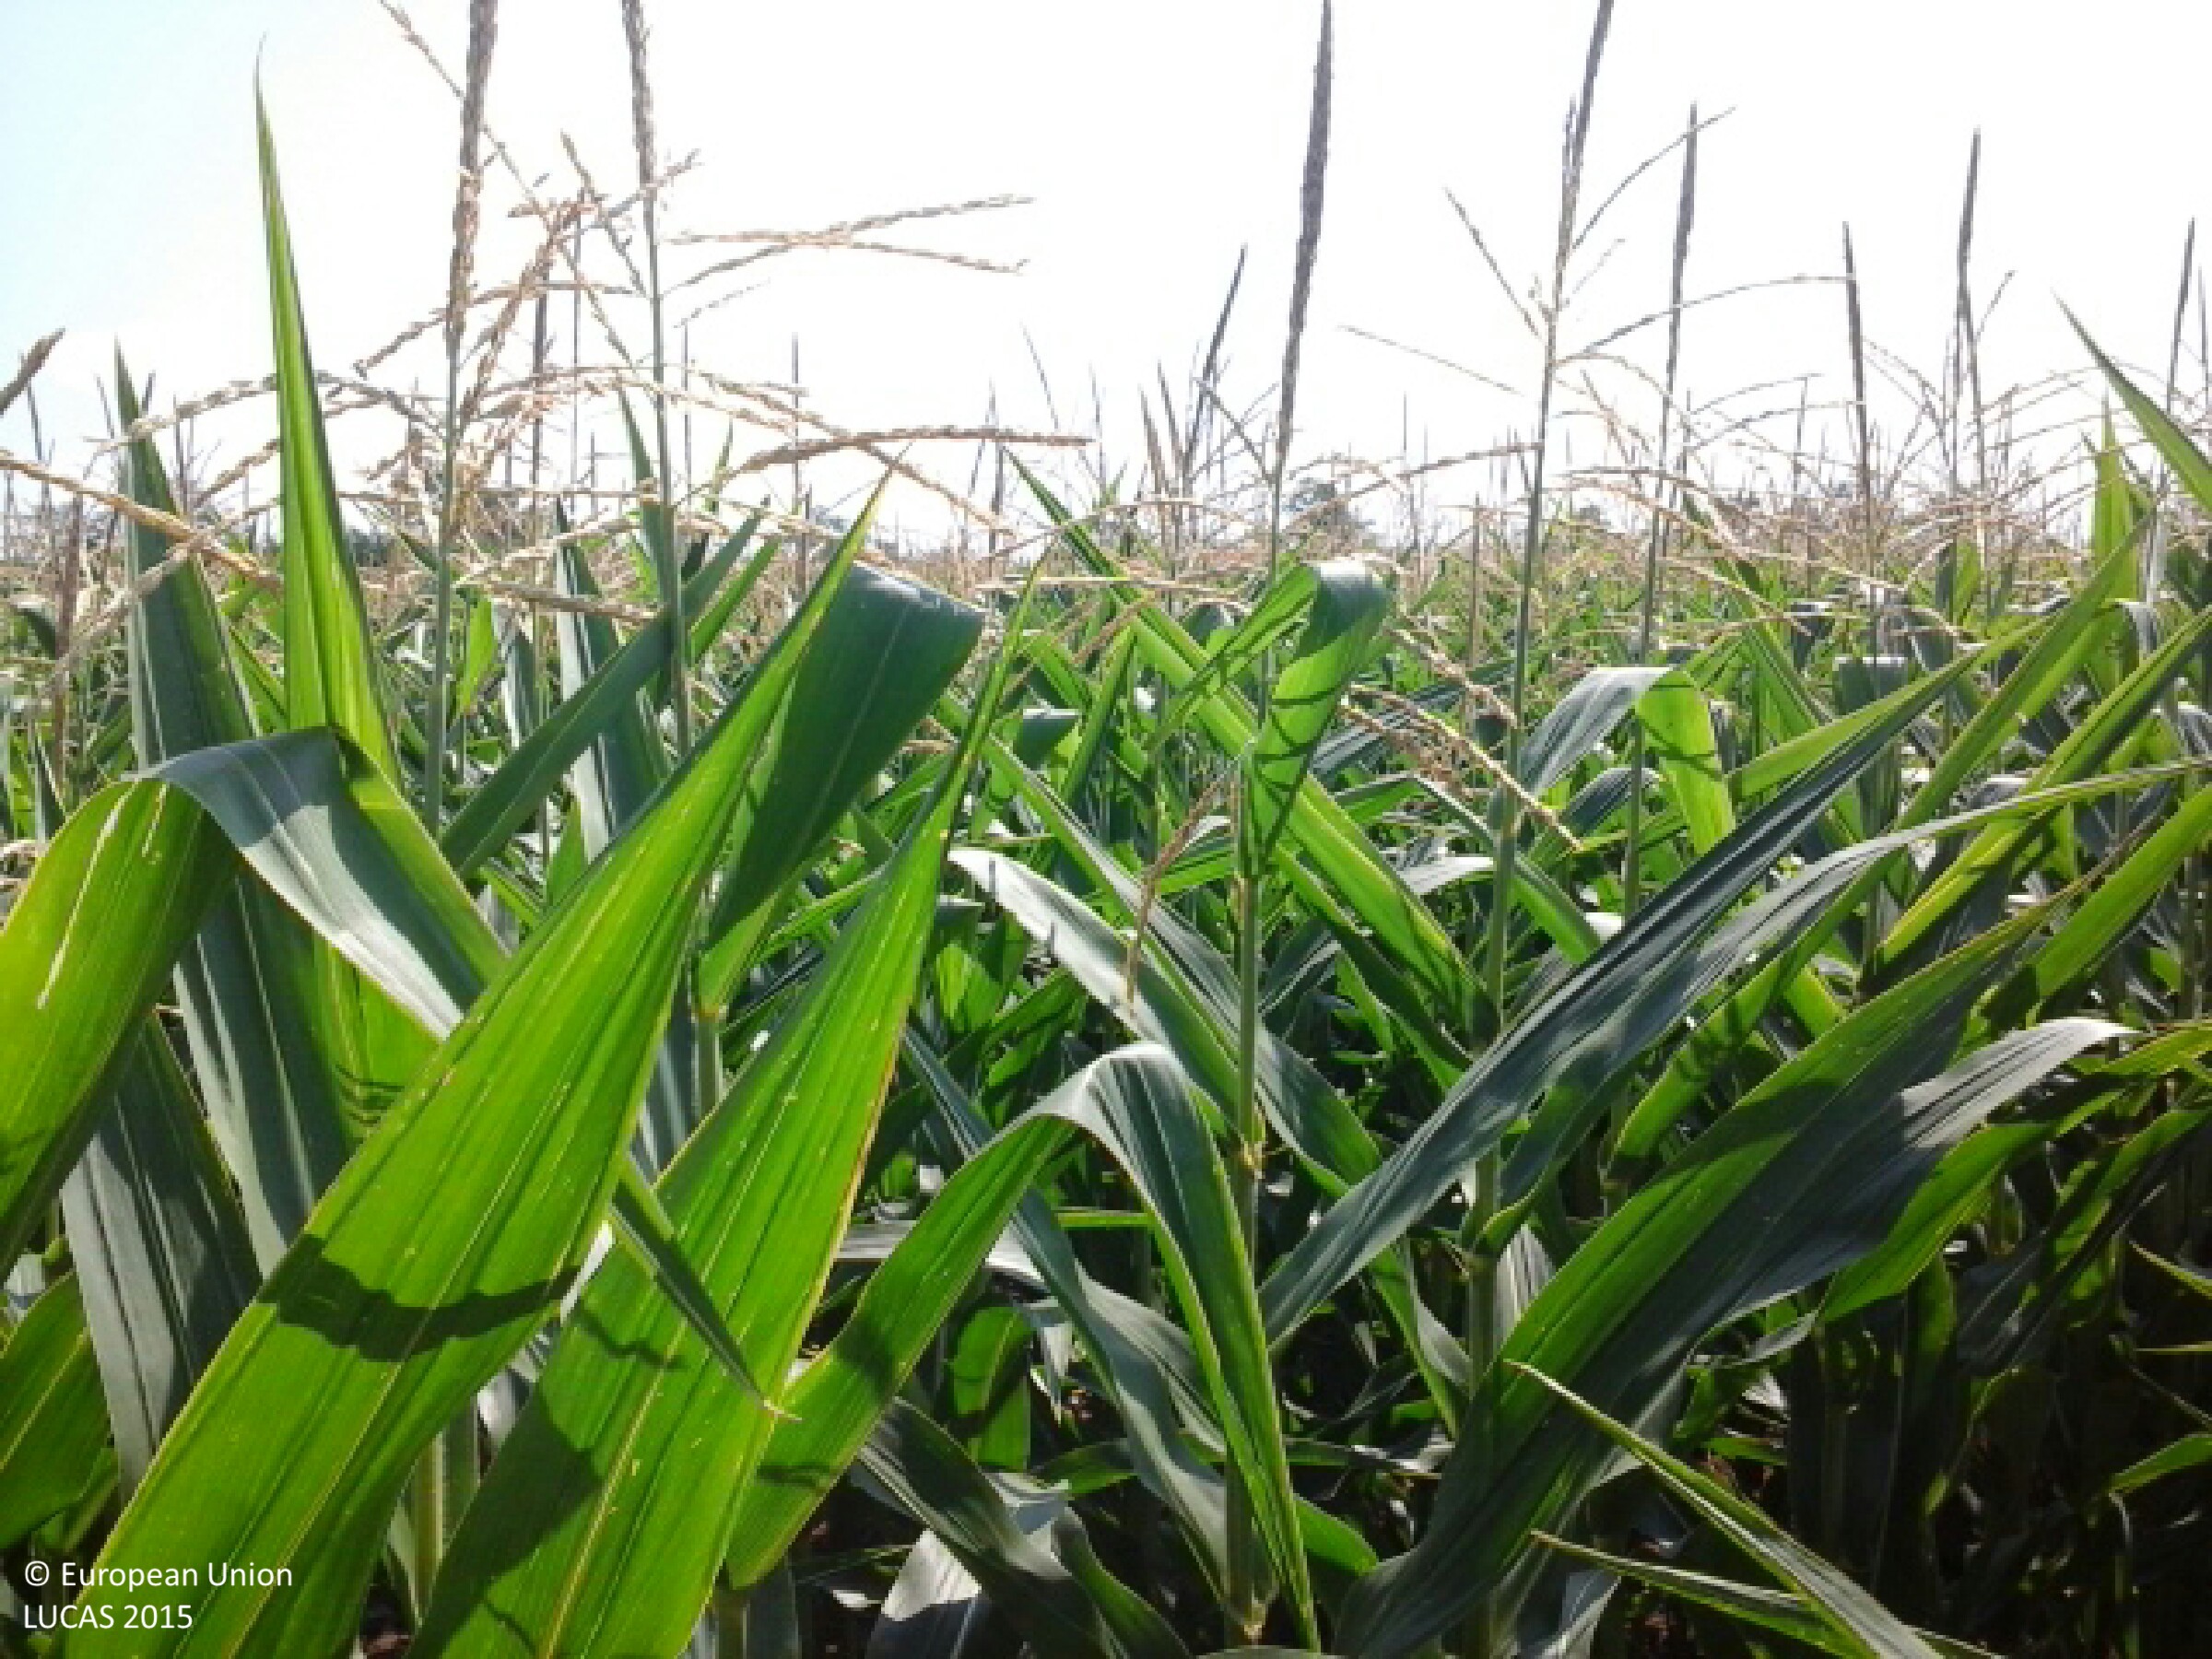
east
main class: Cropland
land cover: Maize
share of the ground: > 75 %
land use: Agriculture (excluding fallow land and kitchen gardens)
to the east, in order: Maize; Broadleaved woodland; Ditches and canals; Grass margins; Tracks; Grass margins; Broadleaved woodland; Maize
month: August
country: HU
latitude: 47.5829
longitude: 18.0822
